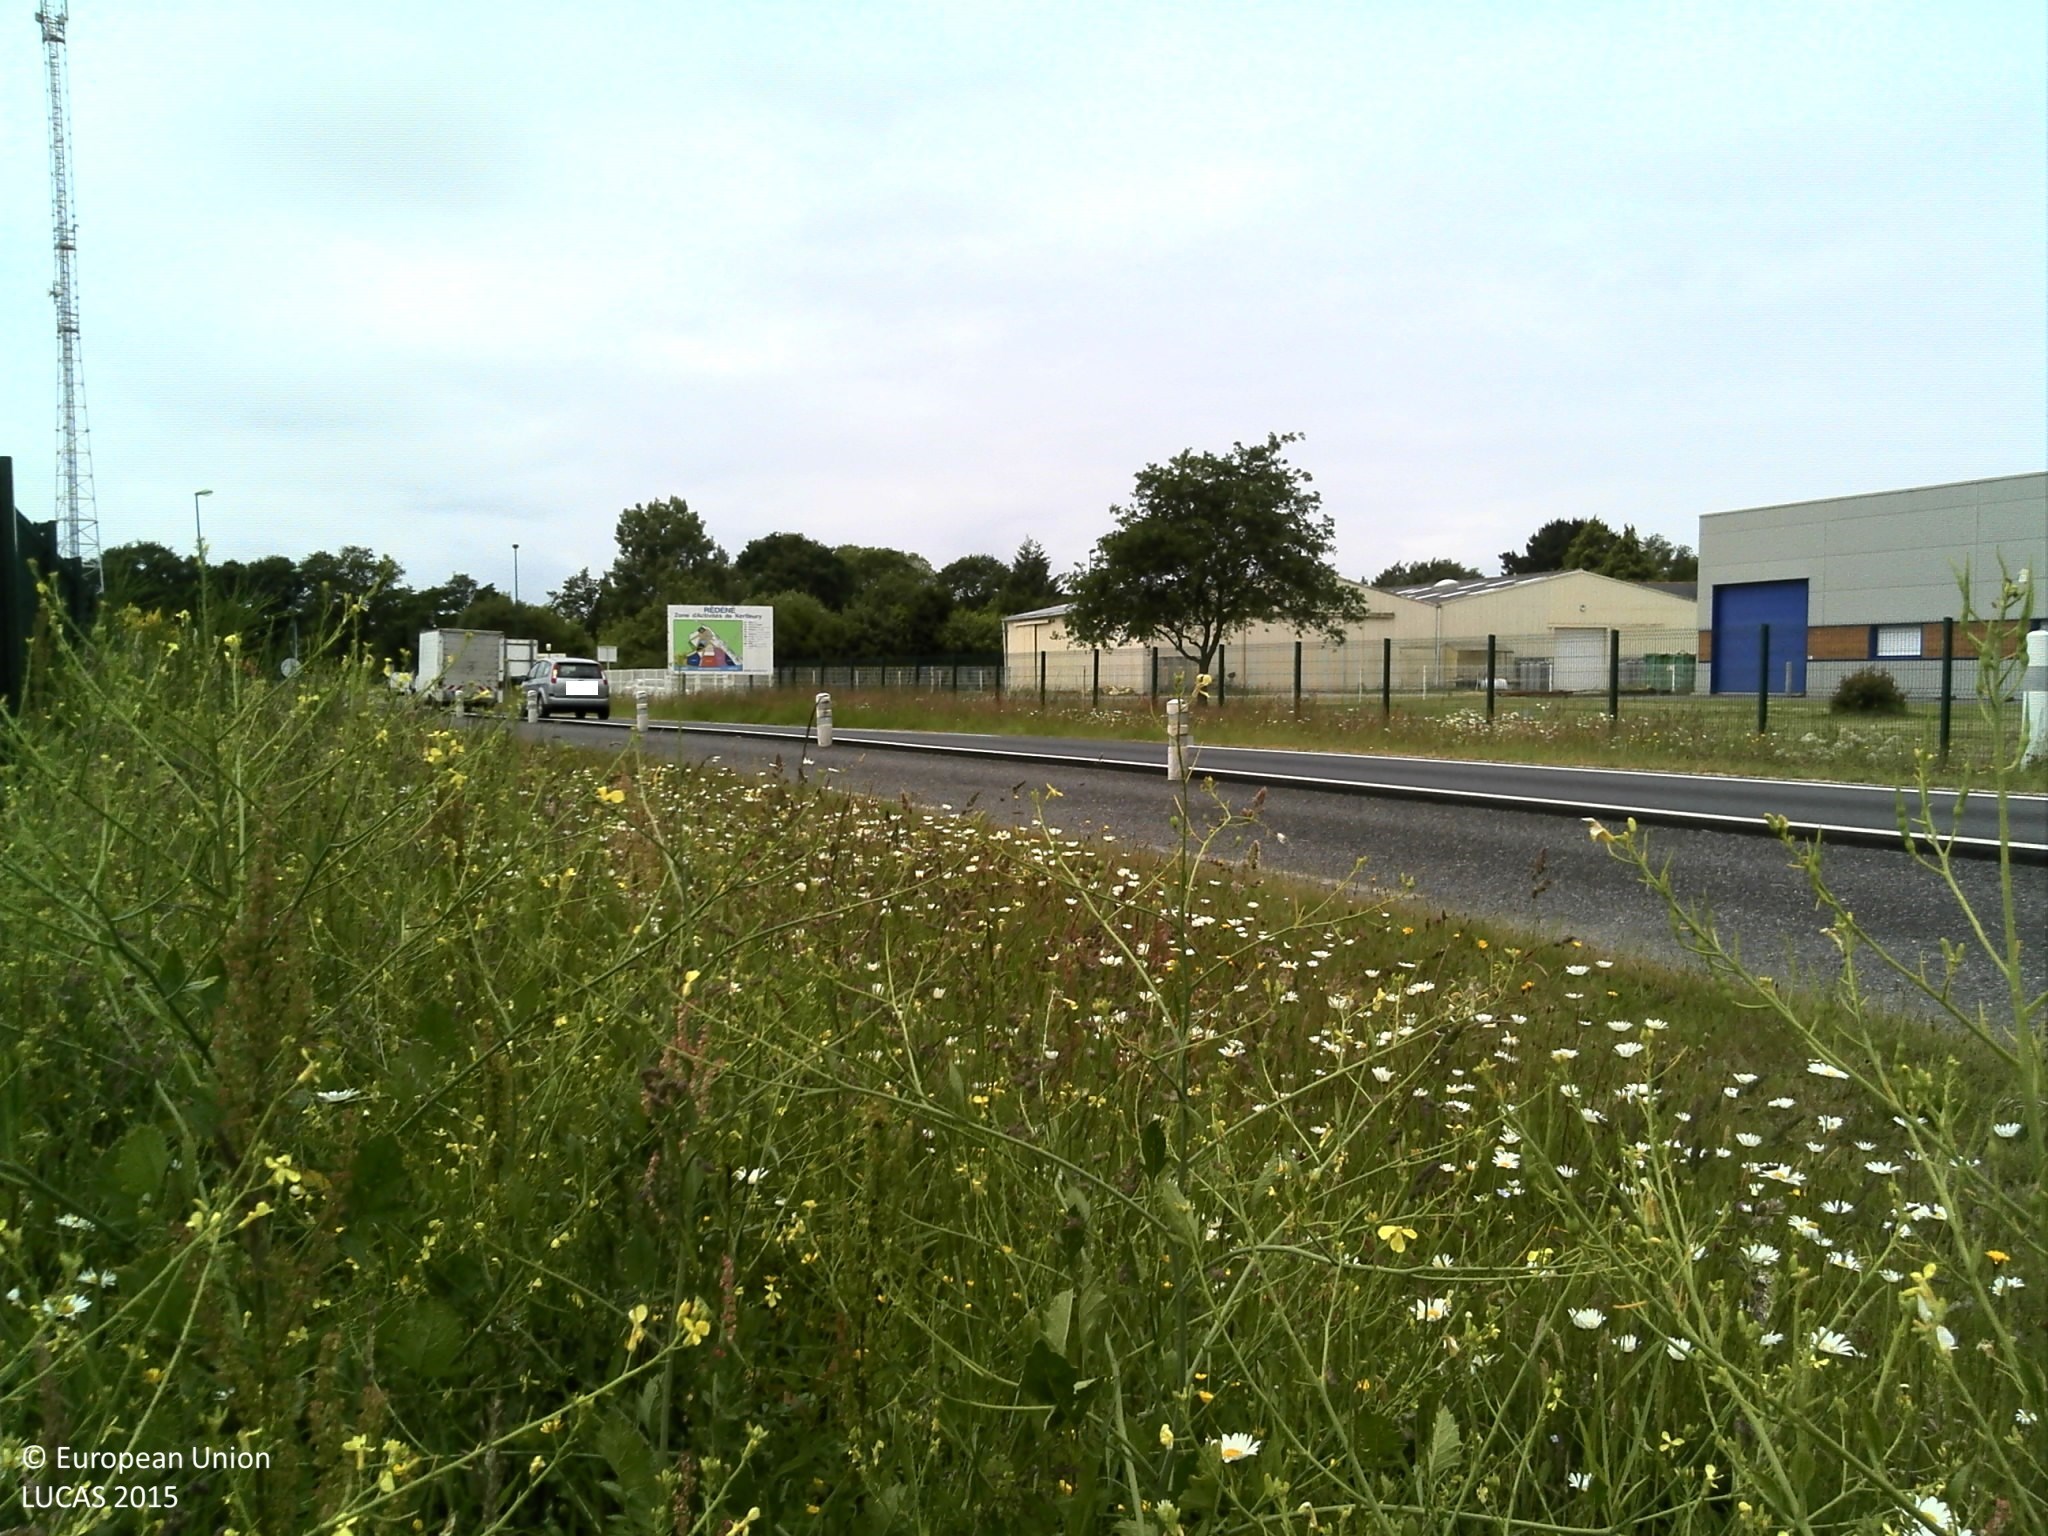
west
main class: Grassland
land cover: Grassland without tree/shrub cover
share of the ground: > 75 %
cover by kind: herbaceous plants 100 %
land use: Amenities, museums, leisure
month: May
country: FR
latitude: 47.8438
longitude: -3.5051
